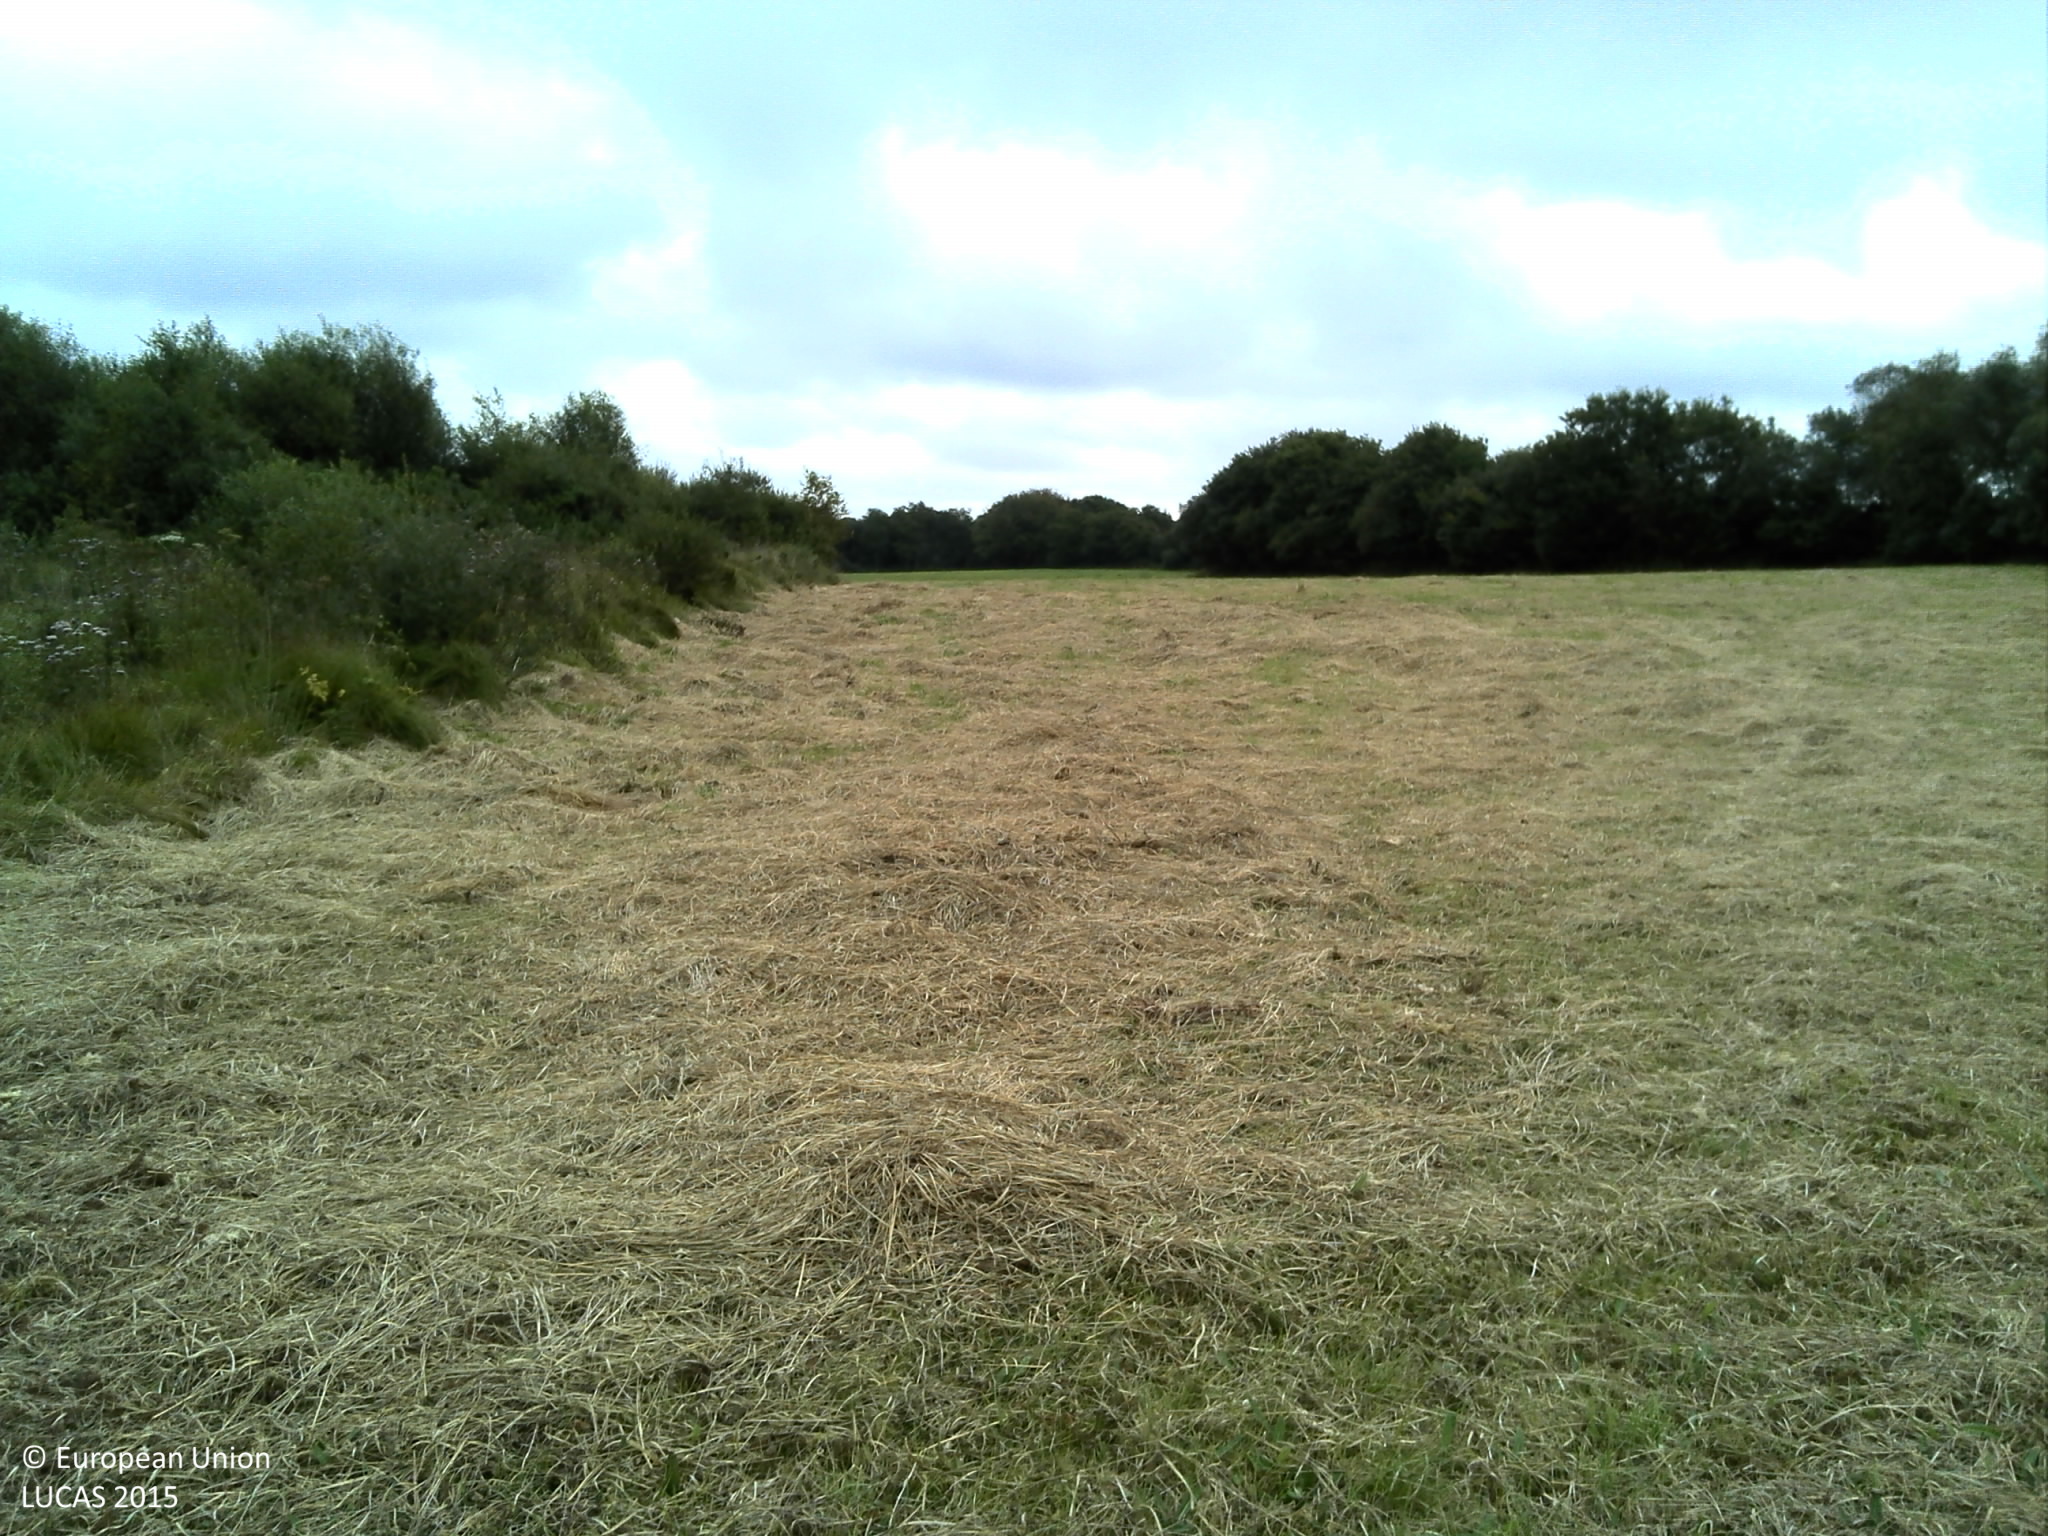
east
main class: Grassland
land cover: Grassland without tree/shrub cover
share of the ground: > 75 %
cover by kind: herbaceous plants 100 %
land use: Agriculture (excluding fallow land and kitchen gardens)
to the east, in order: Grassland without tree/shrub cover; Broadleaved woodland; Grassland without tree/shrub cover
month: September
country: FR
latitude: 48.5136
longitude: -4.2678
